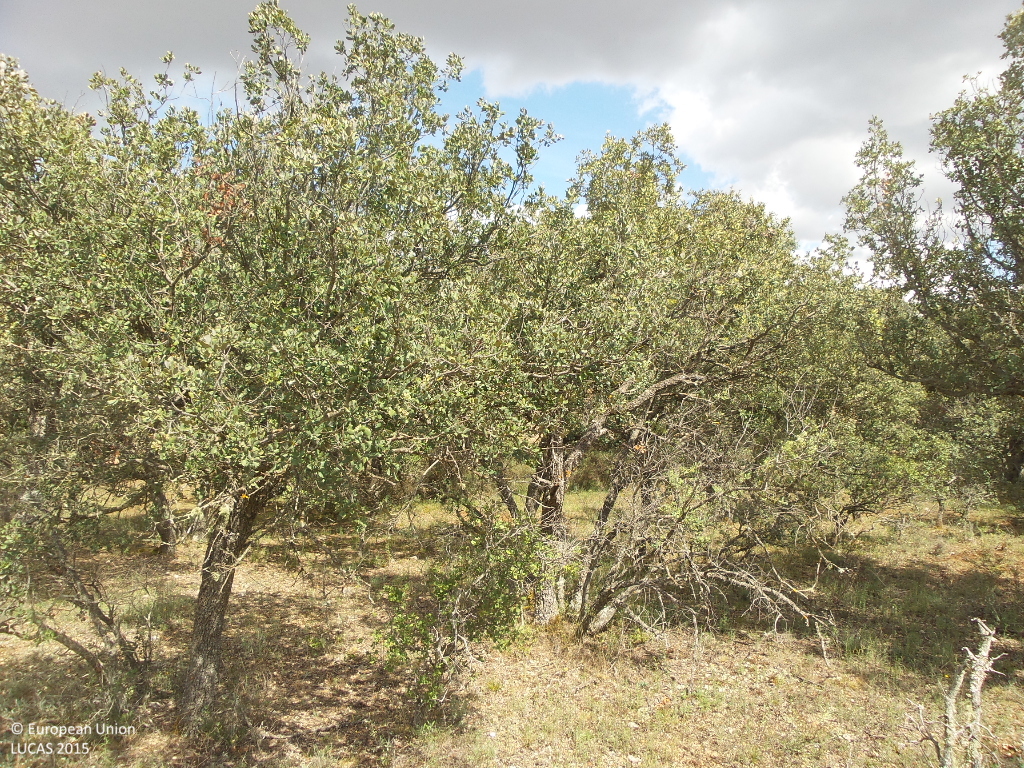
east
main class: Woodland
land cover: Broadleaved woodland
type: broadleaved evergreen forest
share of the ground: 50 - 75 %
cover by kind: broadleaved forest trees 65 %, unconsolidated bare surface 15 %, shrubs 10 %, herbaceous plants 10 %
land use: Forestry
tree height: < 5 m
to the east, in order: Broadleaved woodland
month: June
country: ES
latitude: 41.5102
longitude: -3.2118
